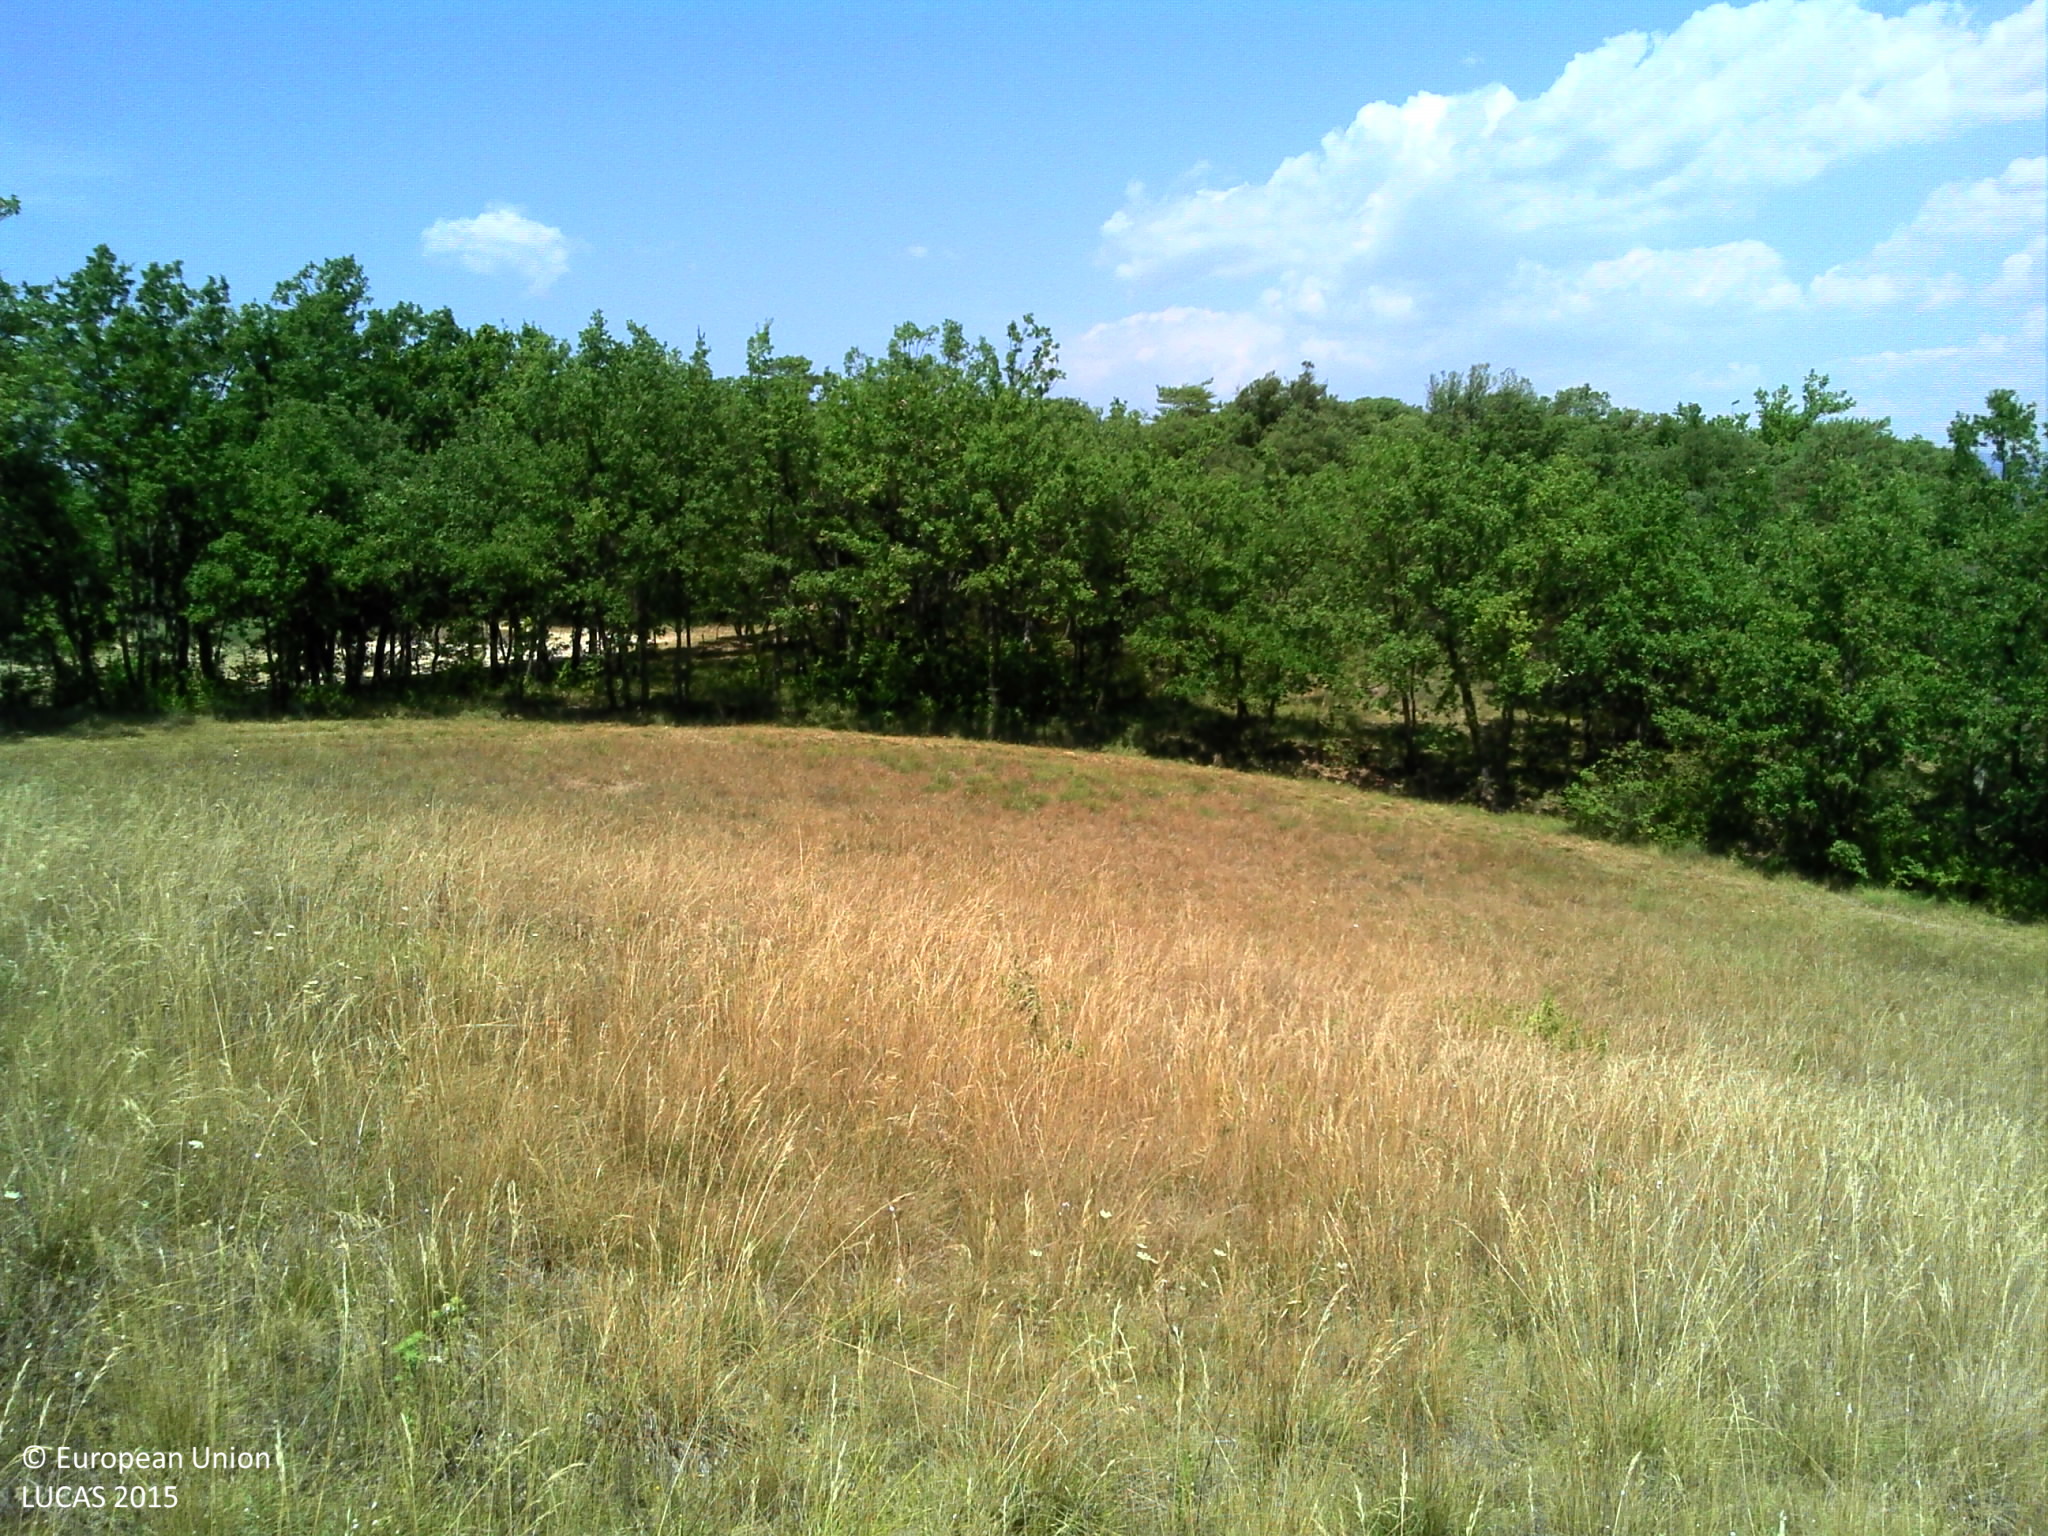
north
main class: Grassland
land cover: Spontaneously vegetated surfaces
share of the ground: > 75 %
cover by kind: herbaceous plants 95 %, lichens and mosses 5 %
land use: Semi-natural and natural areas not in use
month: August
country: FR
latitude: 43.8452
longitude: 5.2697
